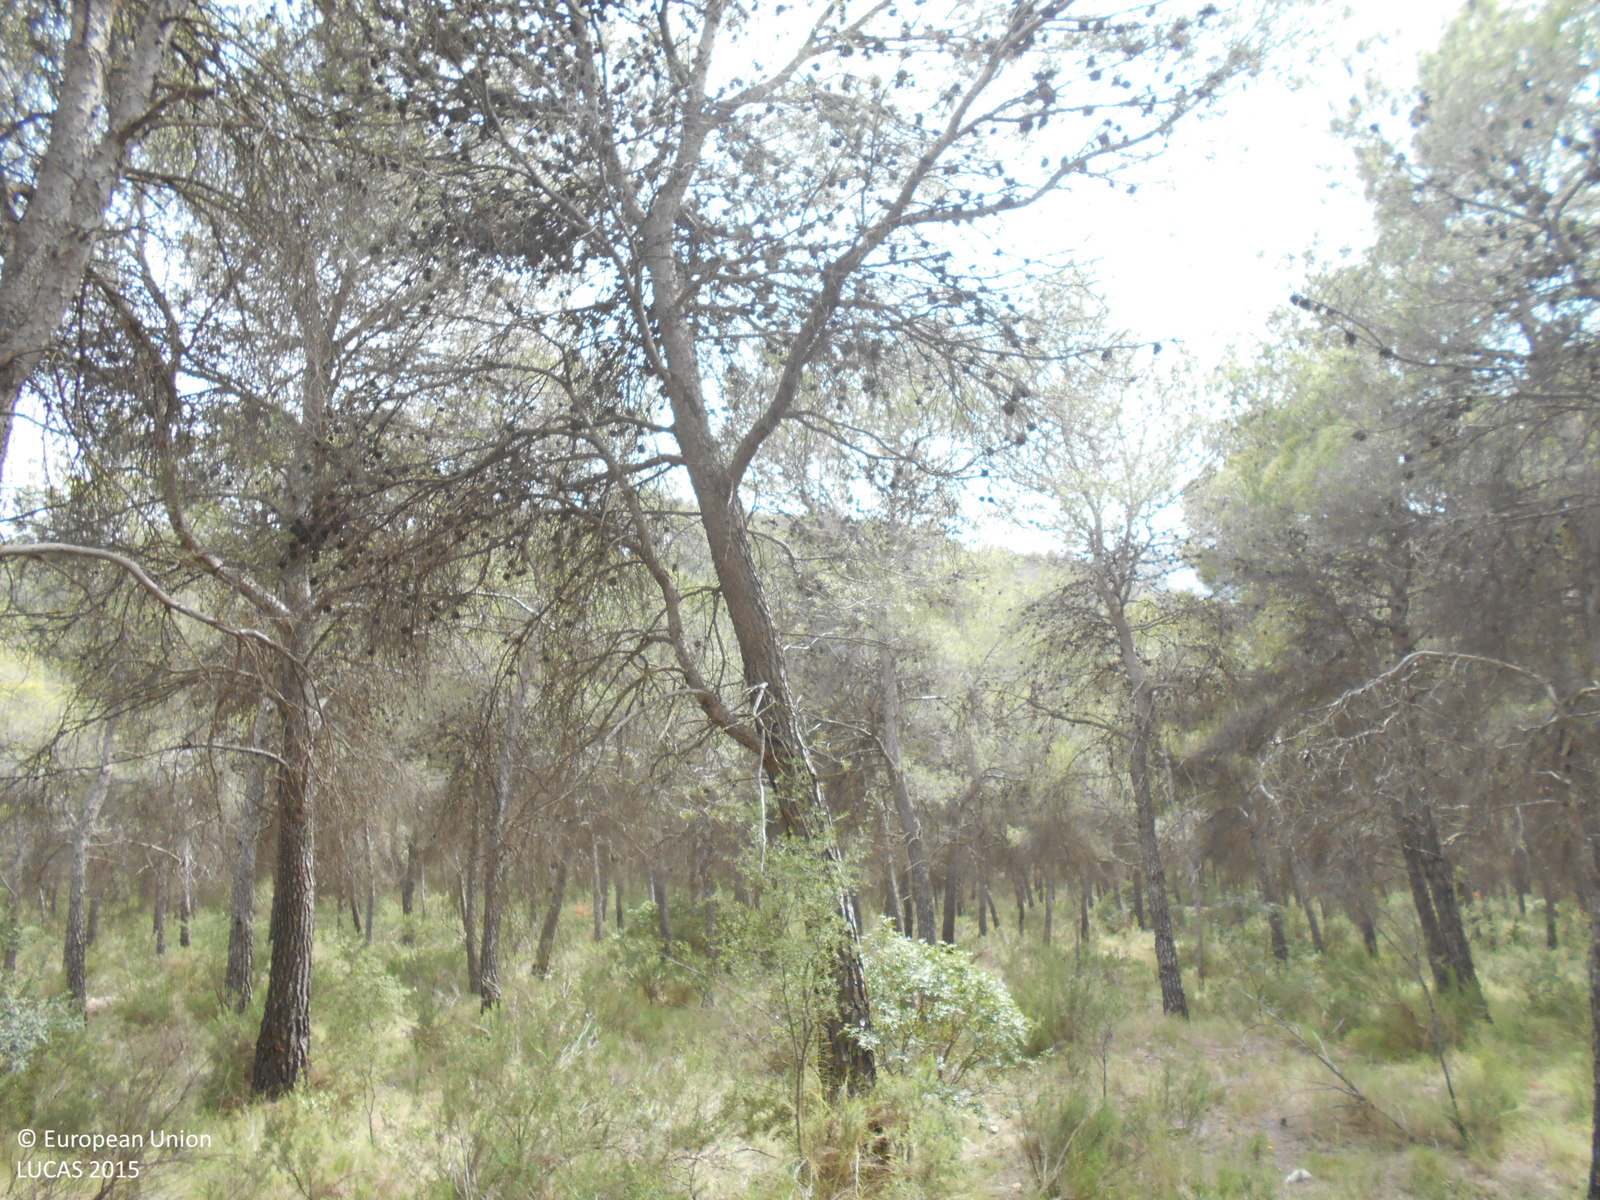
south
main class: Woodland
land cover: Pine dominated coniferous woodland
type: coniferous forest of the mediterranean region
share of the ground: > 75 %
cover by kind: coniferous forest trees 75 %, shrubs 20 %, unconsolidated bare surface 5 %
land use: Semi-natural and natural areas not in use
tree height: > 5 m
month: April
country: ES
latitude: 37.8708
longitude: -1.5000
